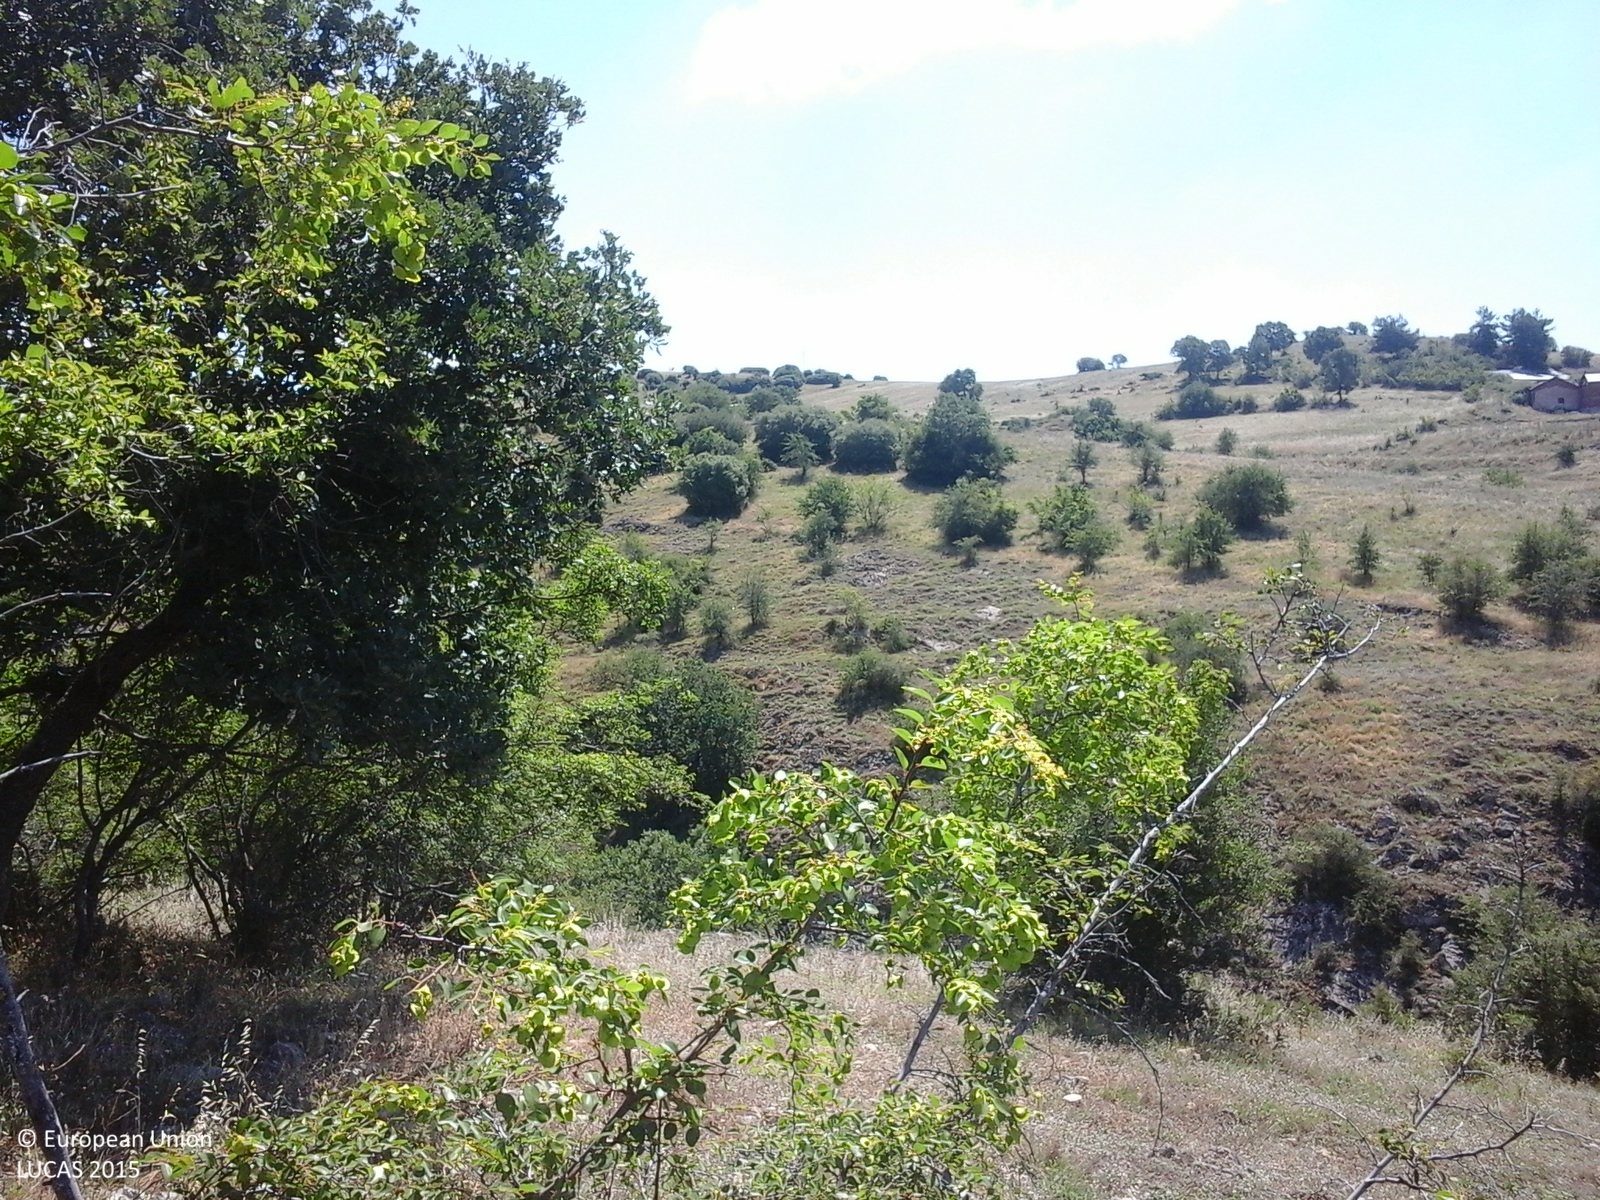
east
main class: Shrubland
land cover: Shrubland without tree cover
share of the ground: 50 - 75 %
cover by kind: shrubs 50 %, herbaceous plants 50 %
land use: Semi-natural and natural areas not in use
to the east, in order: Shrubland without tree cover; Spontaneously vegetated surfaces; Rivers and streams; Shrubland without tree cover; Artificial constructions in urban areas; Grassland without tree/shrub cover
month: June
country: GR
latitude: 40.7771
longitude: 23.2234
